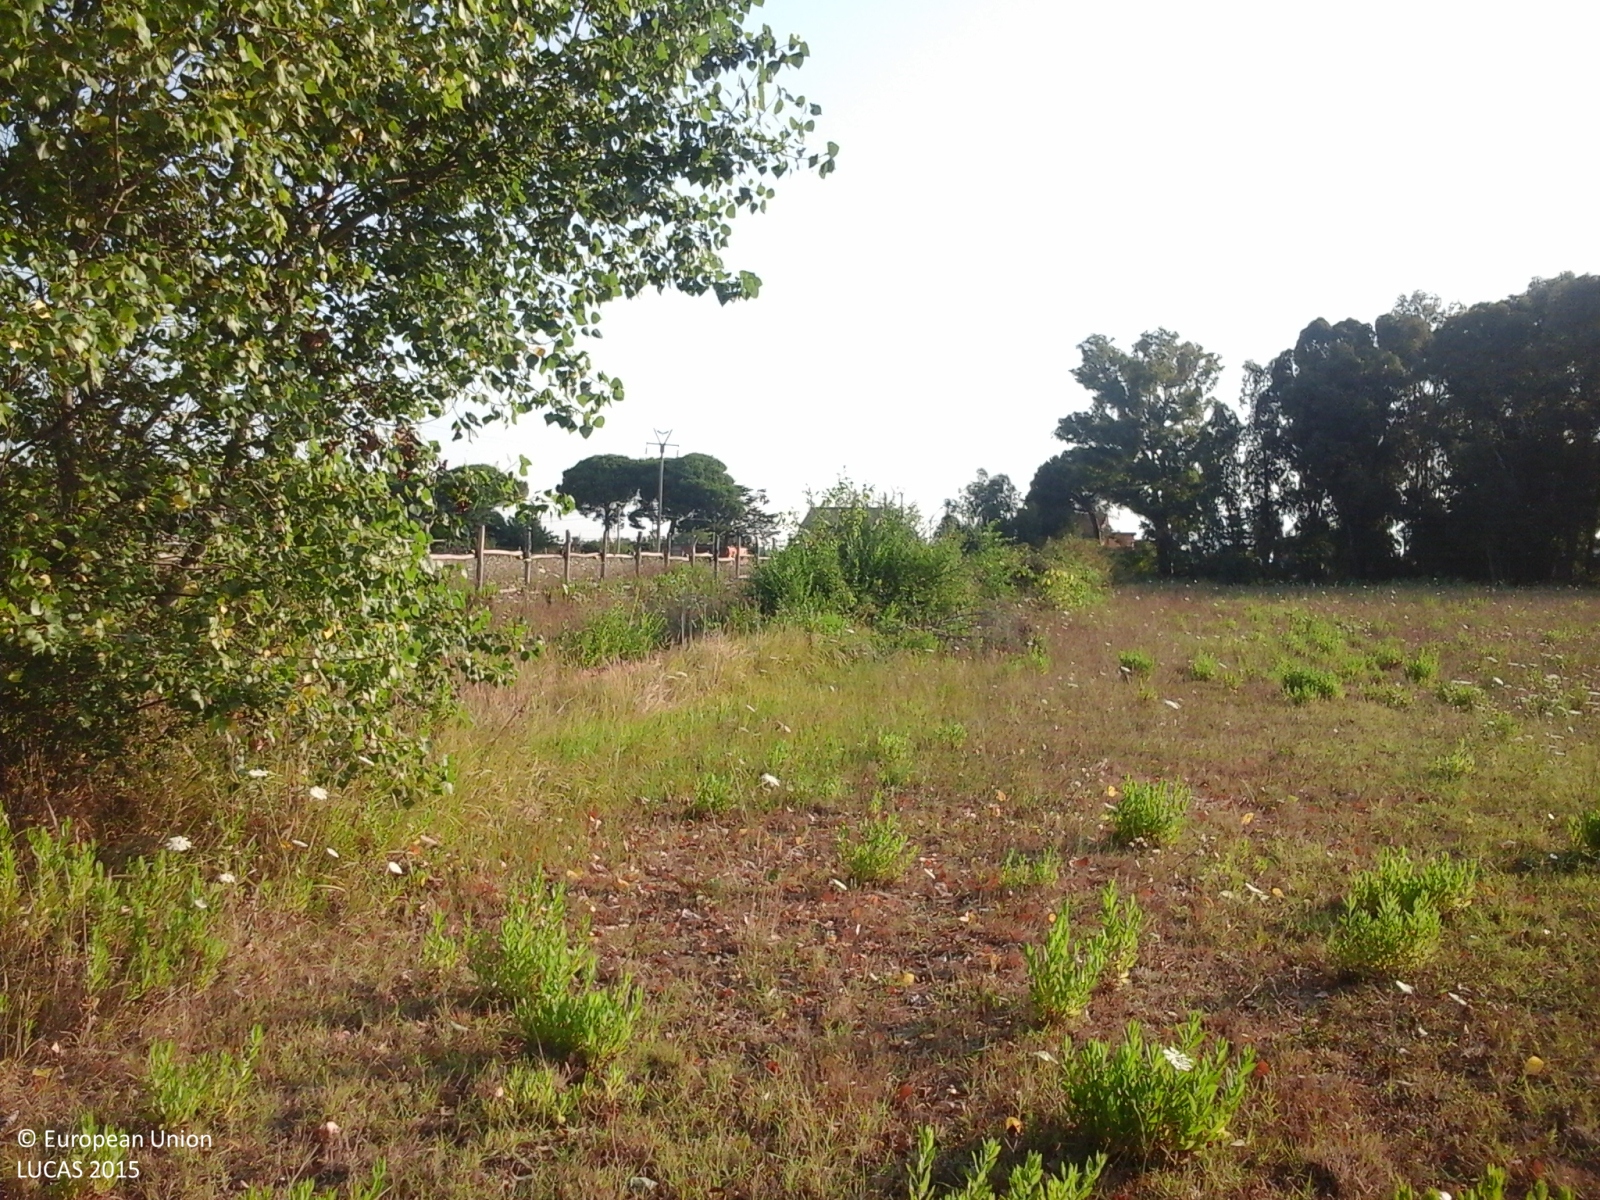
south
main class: Grassland
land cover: Grassland without tree/shrub cover
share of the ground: > 75 %
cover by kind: herbaceous plants 100 %
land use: Residential
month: July
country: IT
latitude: 41.4575
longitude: 12.8259
